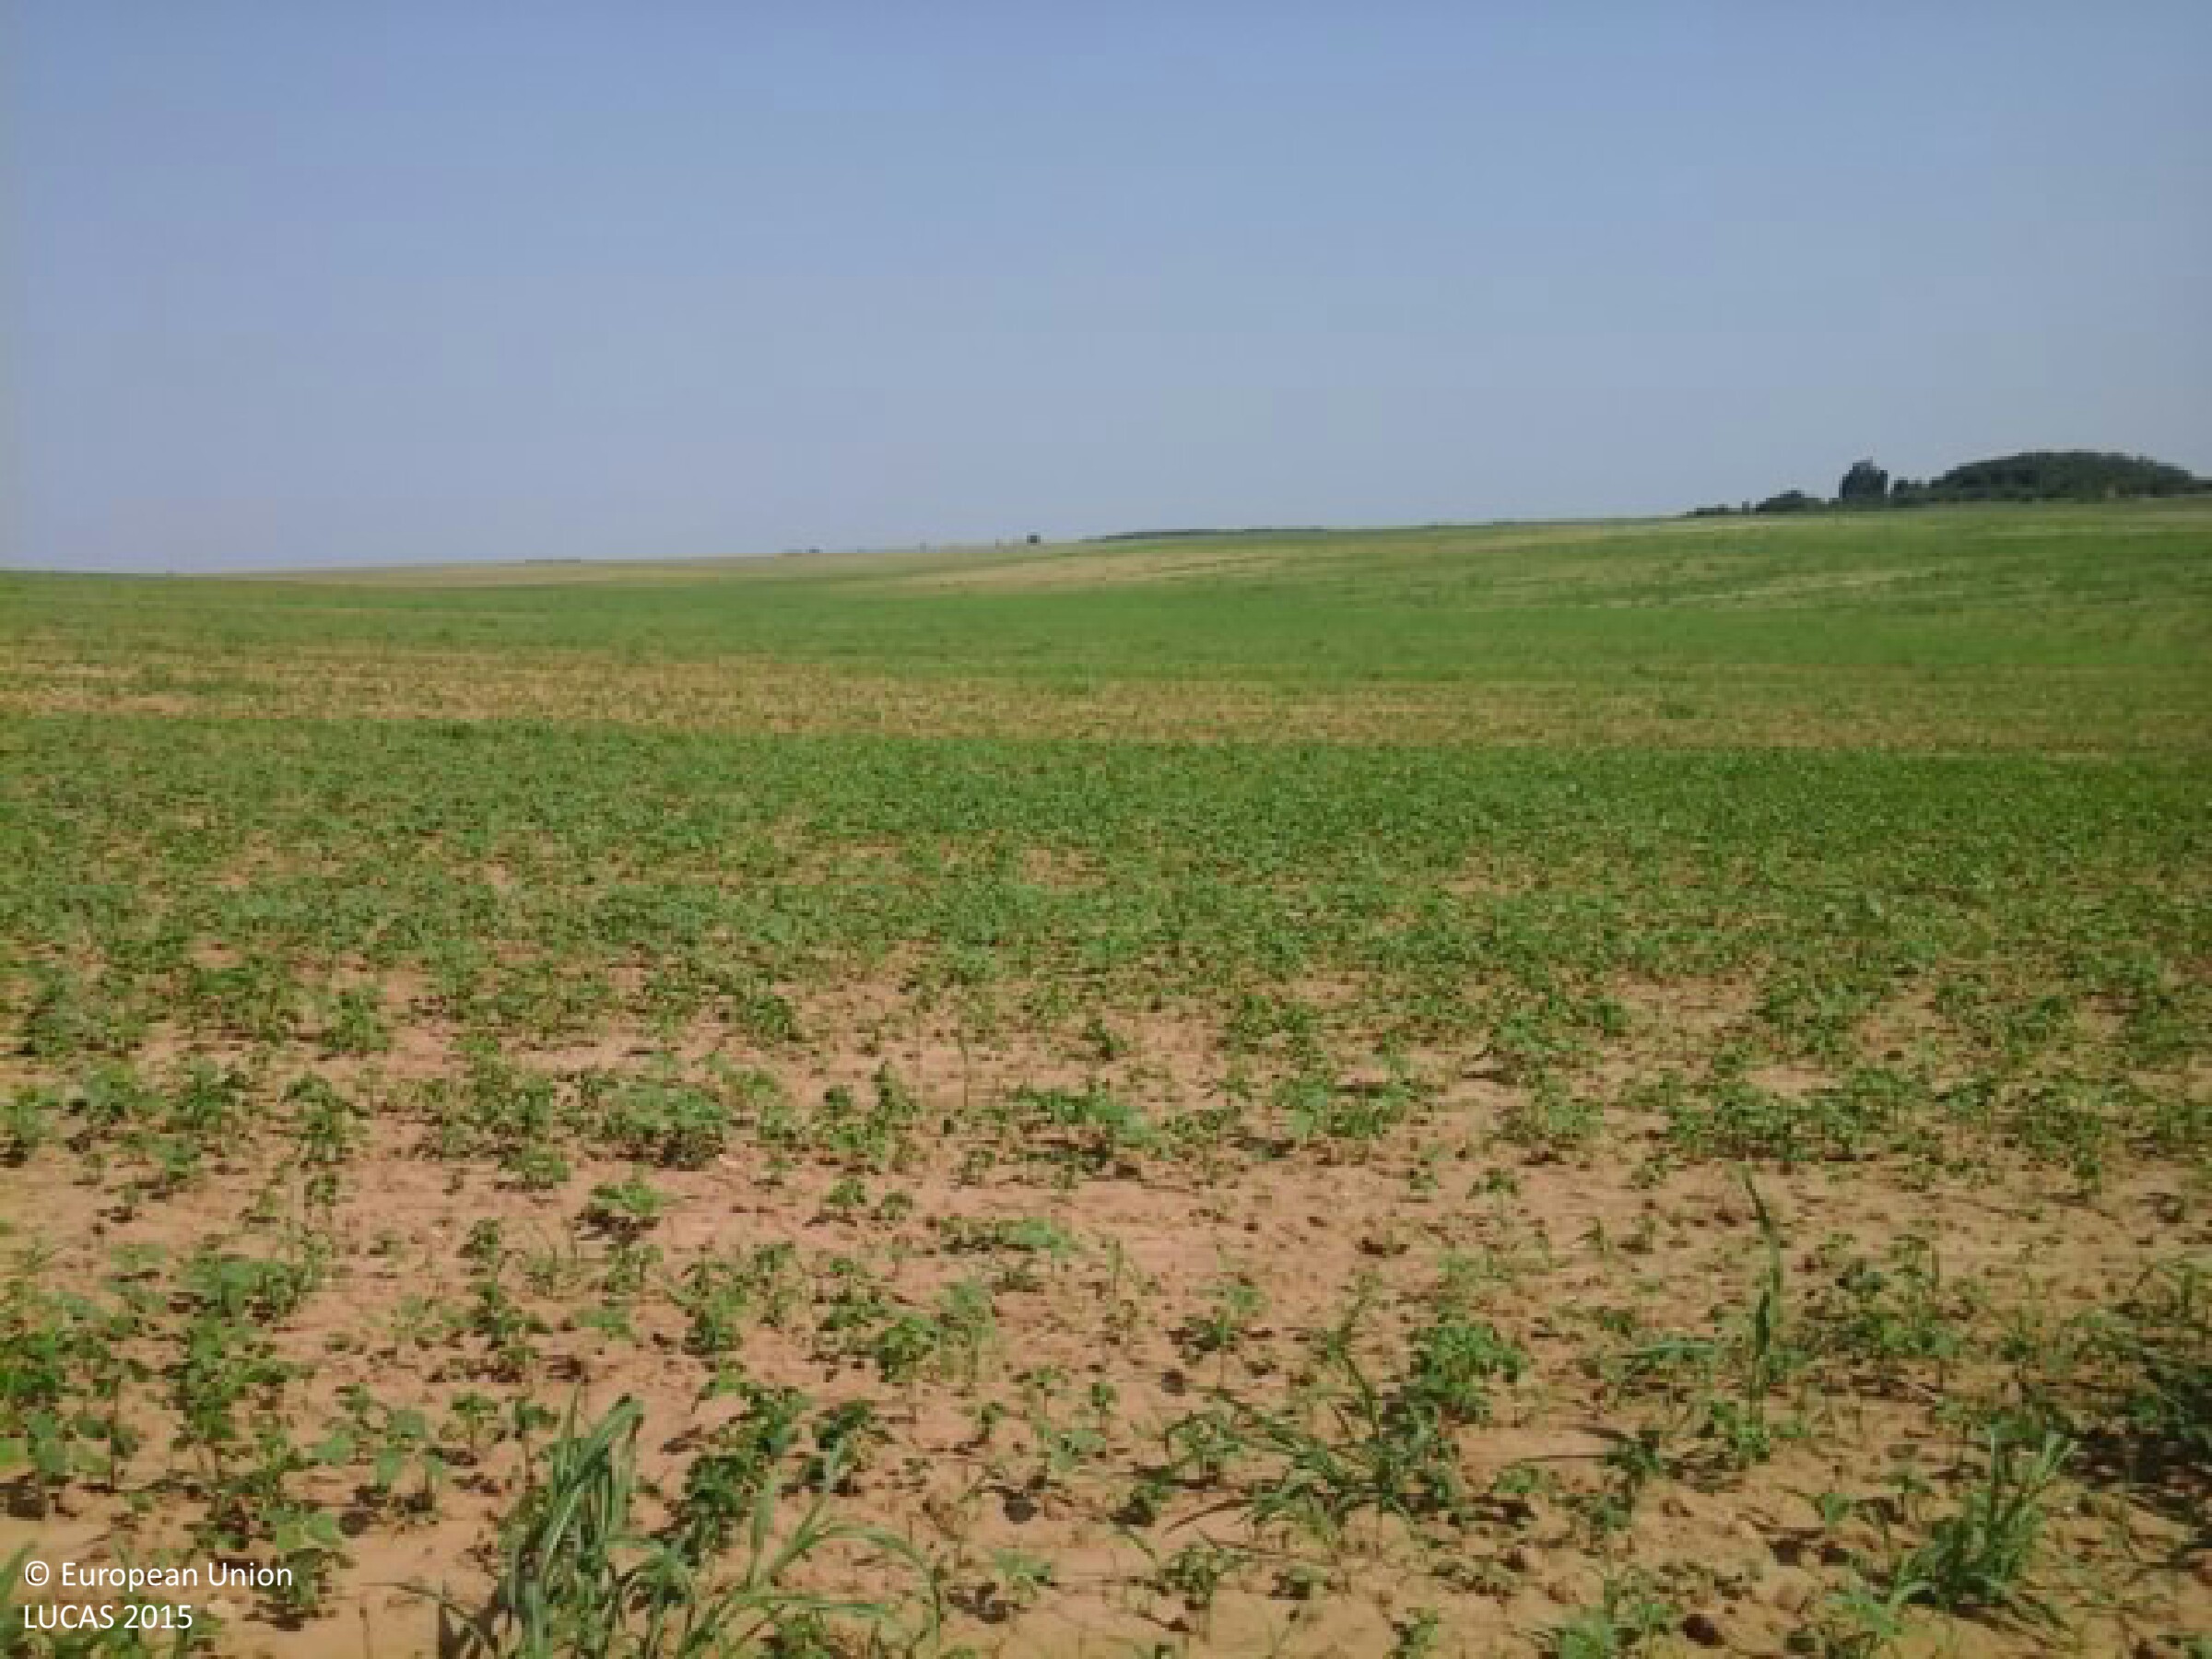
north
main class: Cropland
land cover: Other cereals
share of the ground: 50 - 75 %
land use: Agriculture (excluding fallow land and kitchen gardens)
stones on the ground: < 10 %
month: August
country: HU
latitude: 46.5314
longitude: 17.8686
